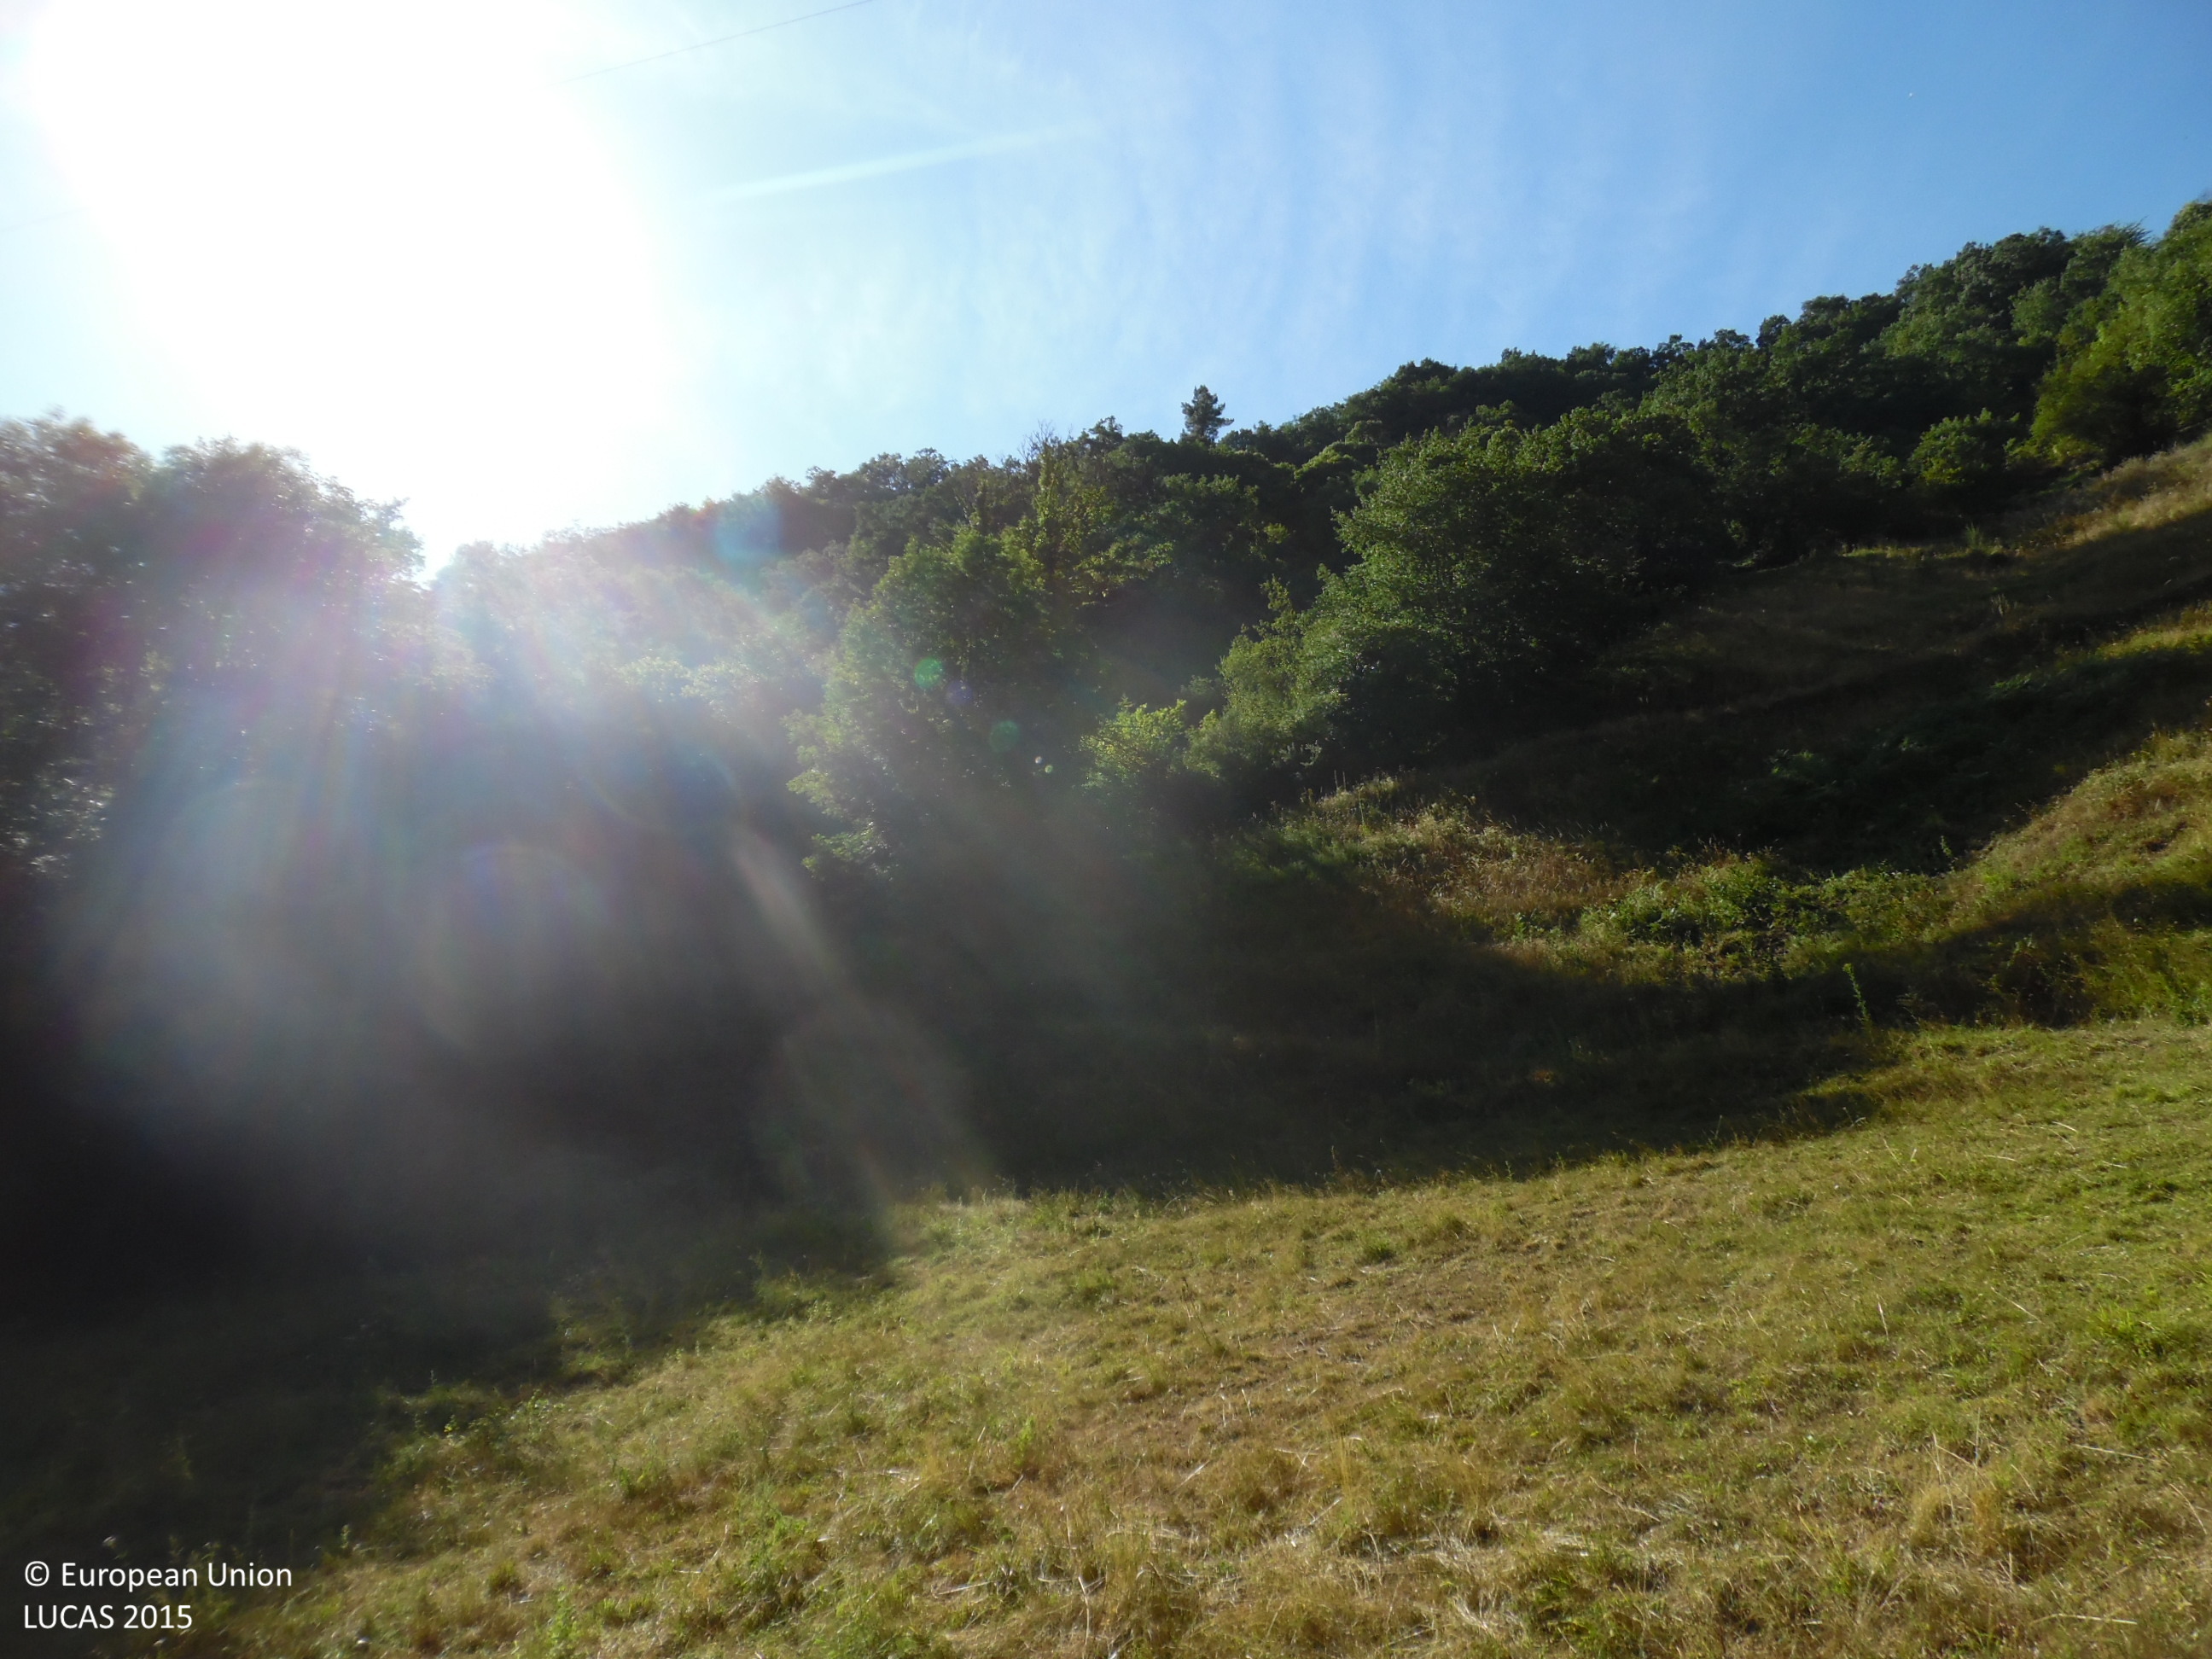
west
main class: Grassland
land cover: Grassland without tree/shrub cover
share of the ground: > 75 %
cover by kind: herbaceous plants 95 %, shrubs 5 %
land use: Agriculture (excluding fallow land and kitchen gardens)
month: July
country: ES
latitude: 43.0842
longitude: -6.5485
